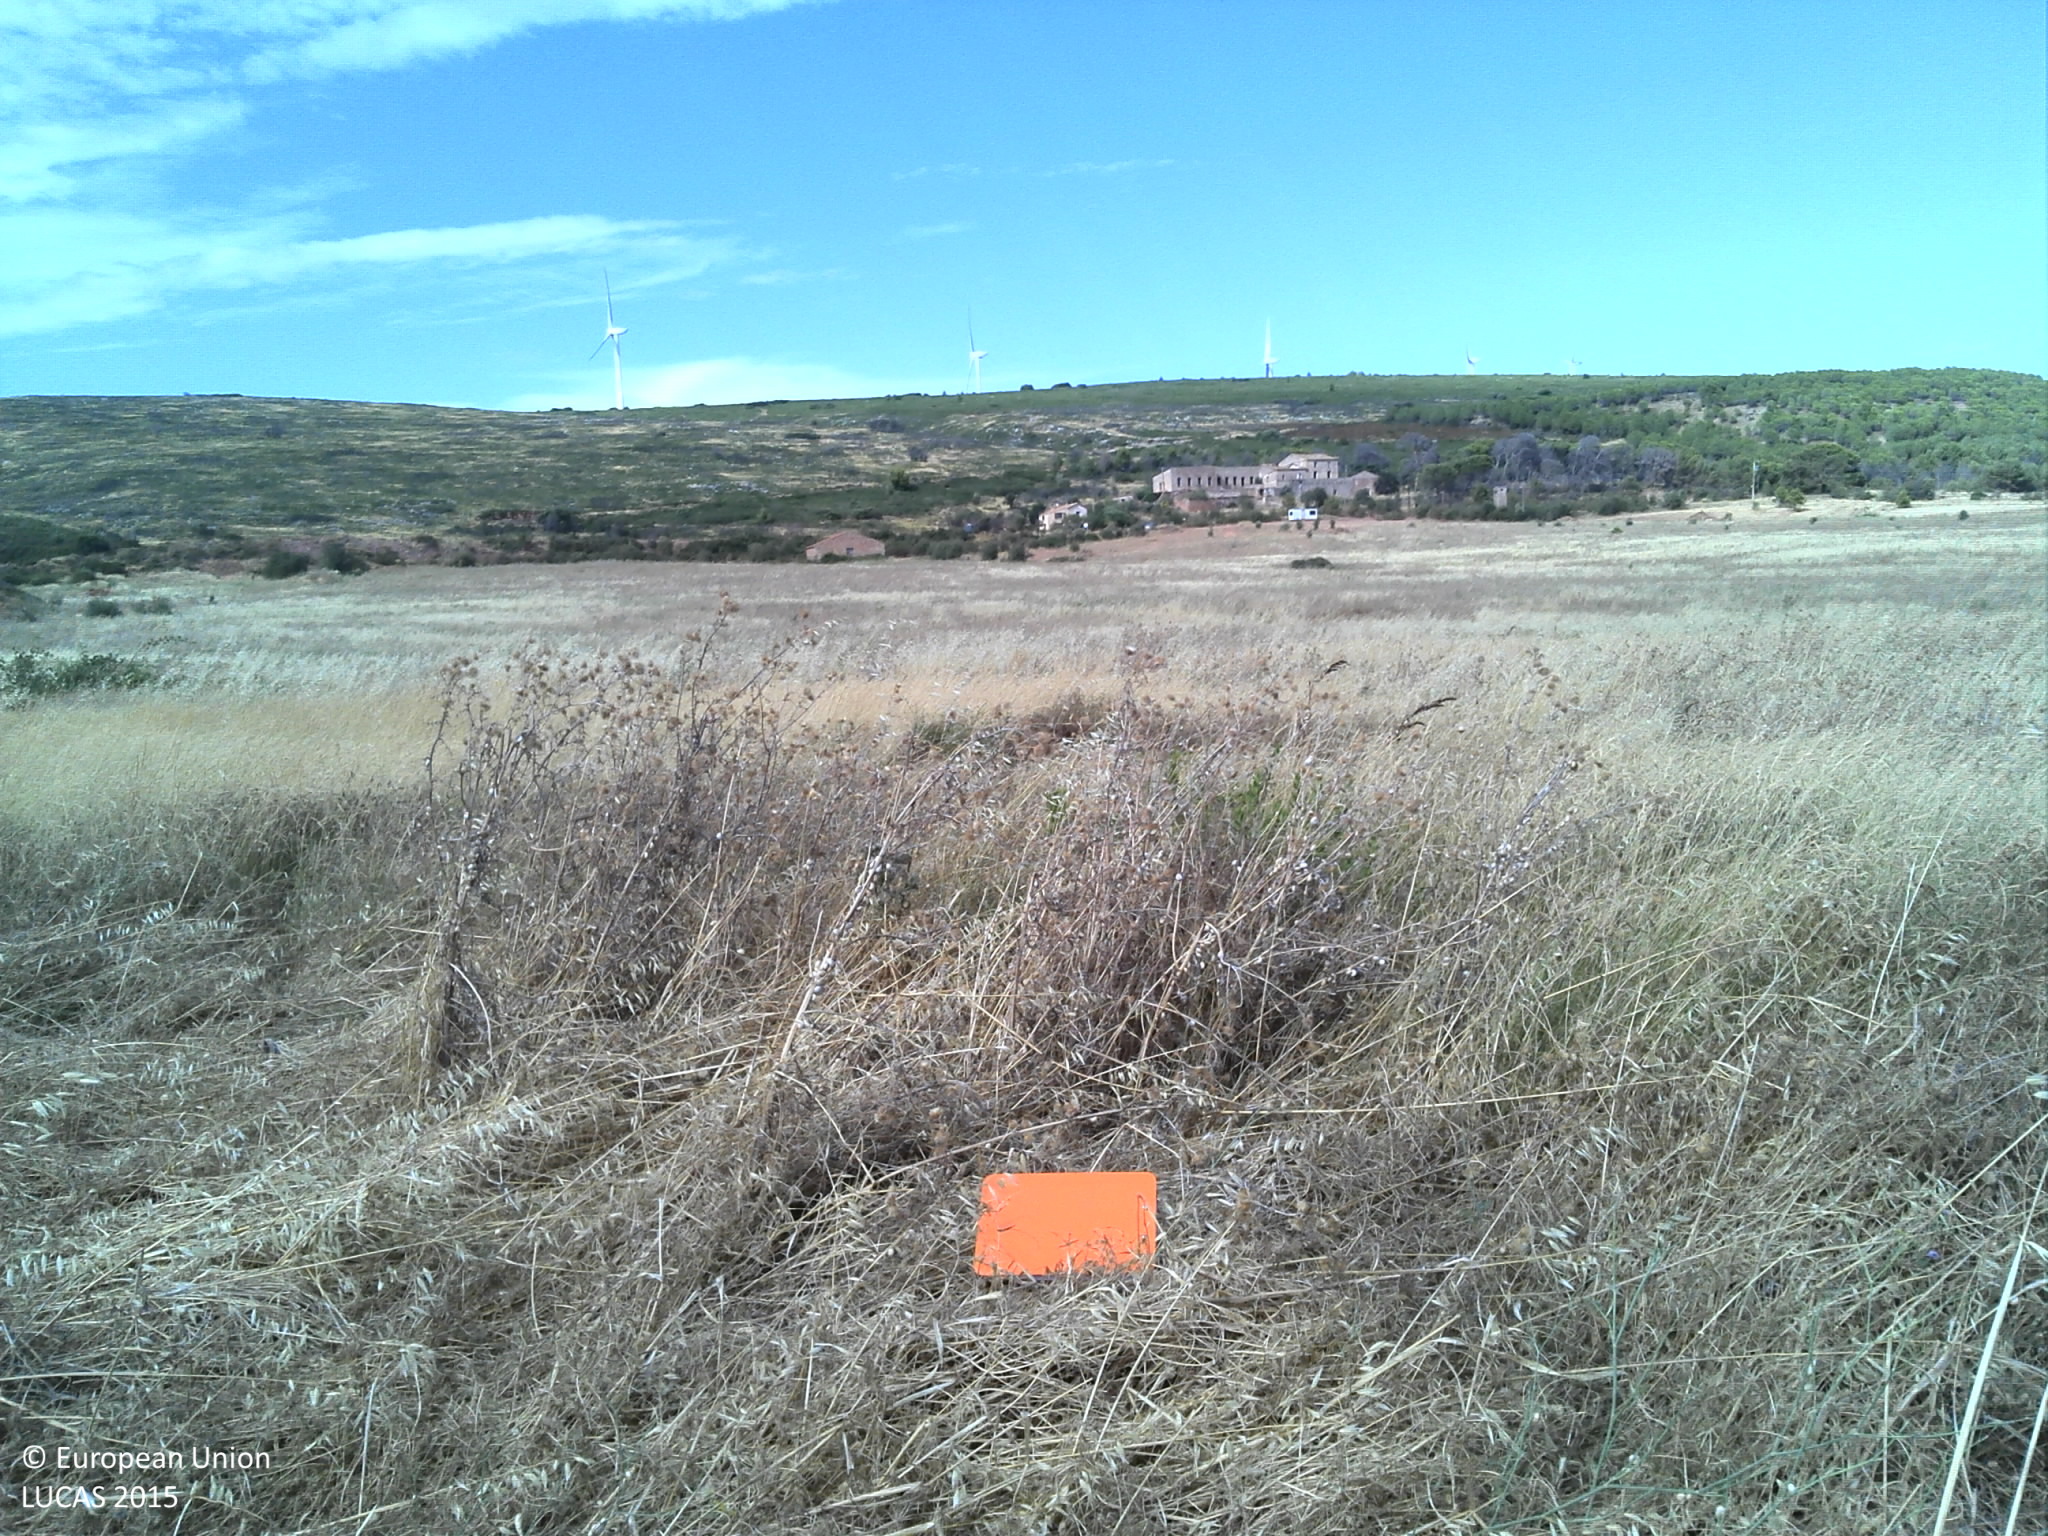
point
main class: Grassland
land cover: Spontaneously vegetated surfaces
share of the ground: > 75 %
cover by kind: herbaceous plants 100 %
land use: Fallow land
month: July
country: FR
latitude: 43.5190
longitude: 3.5885
